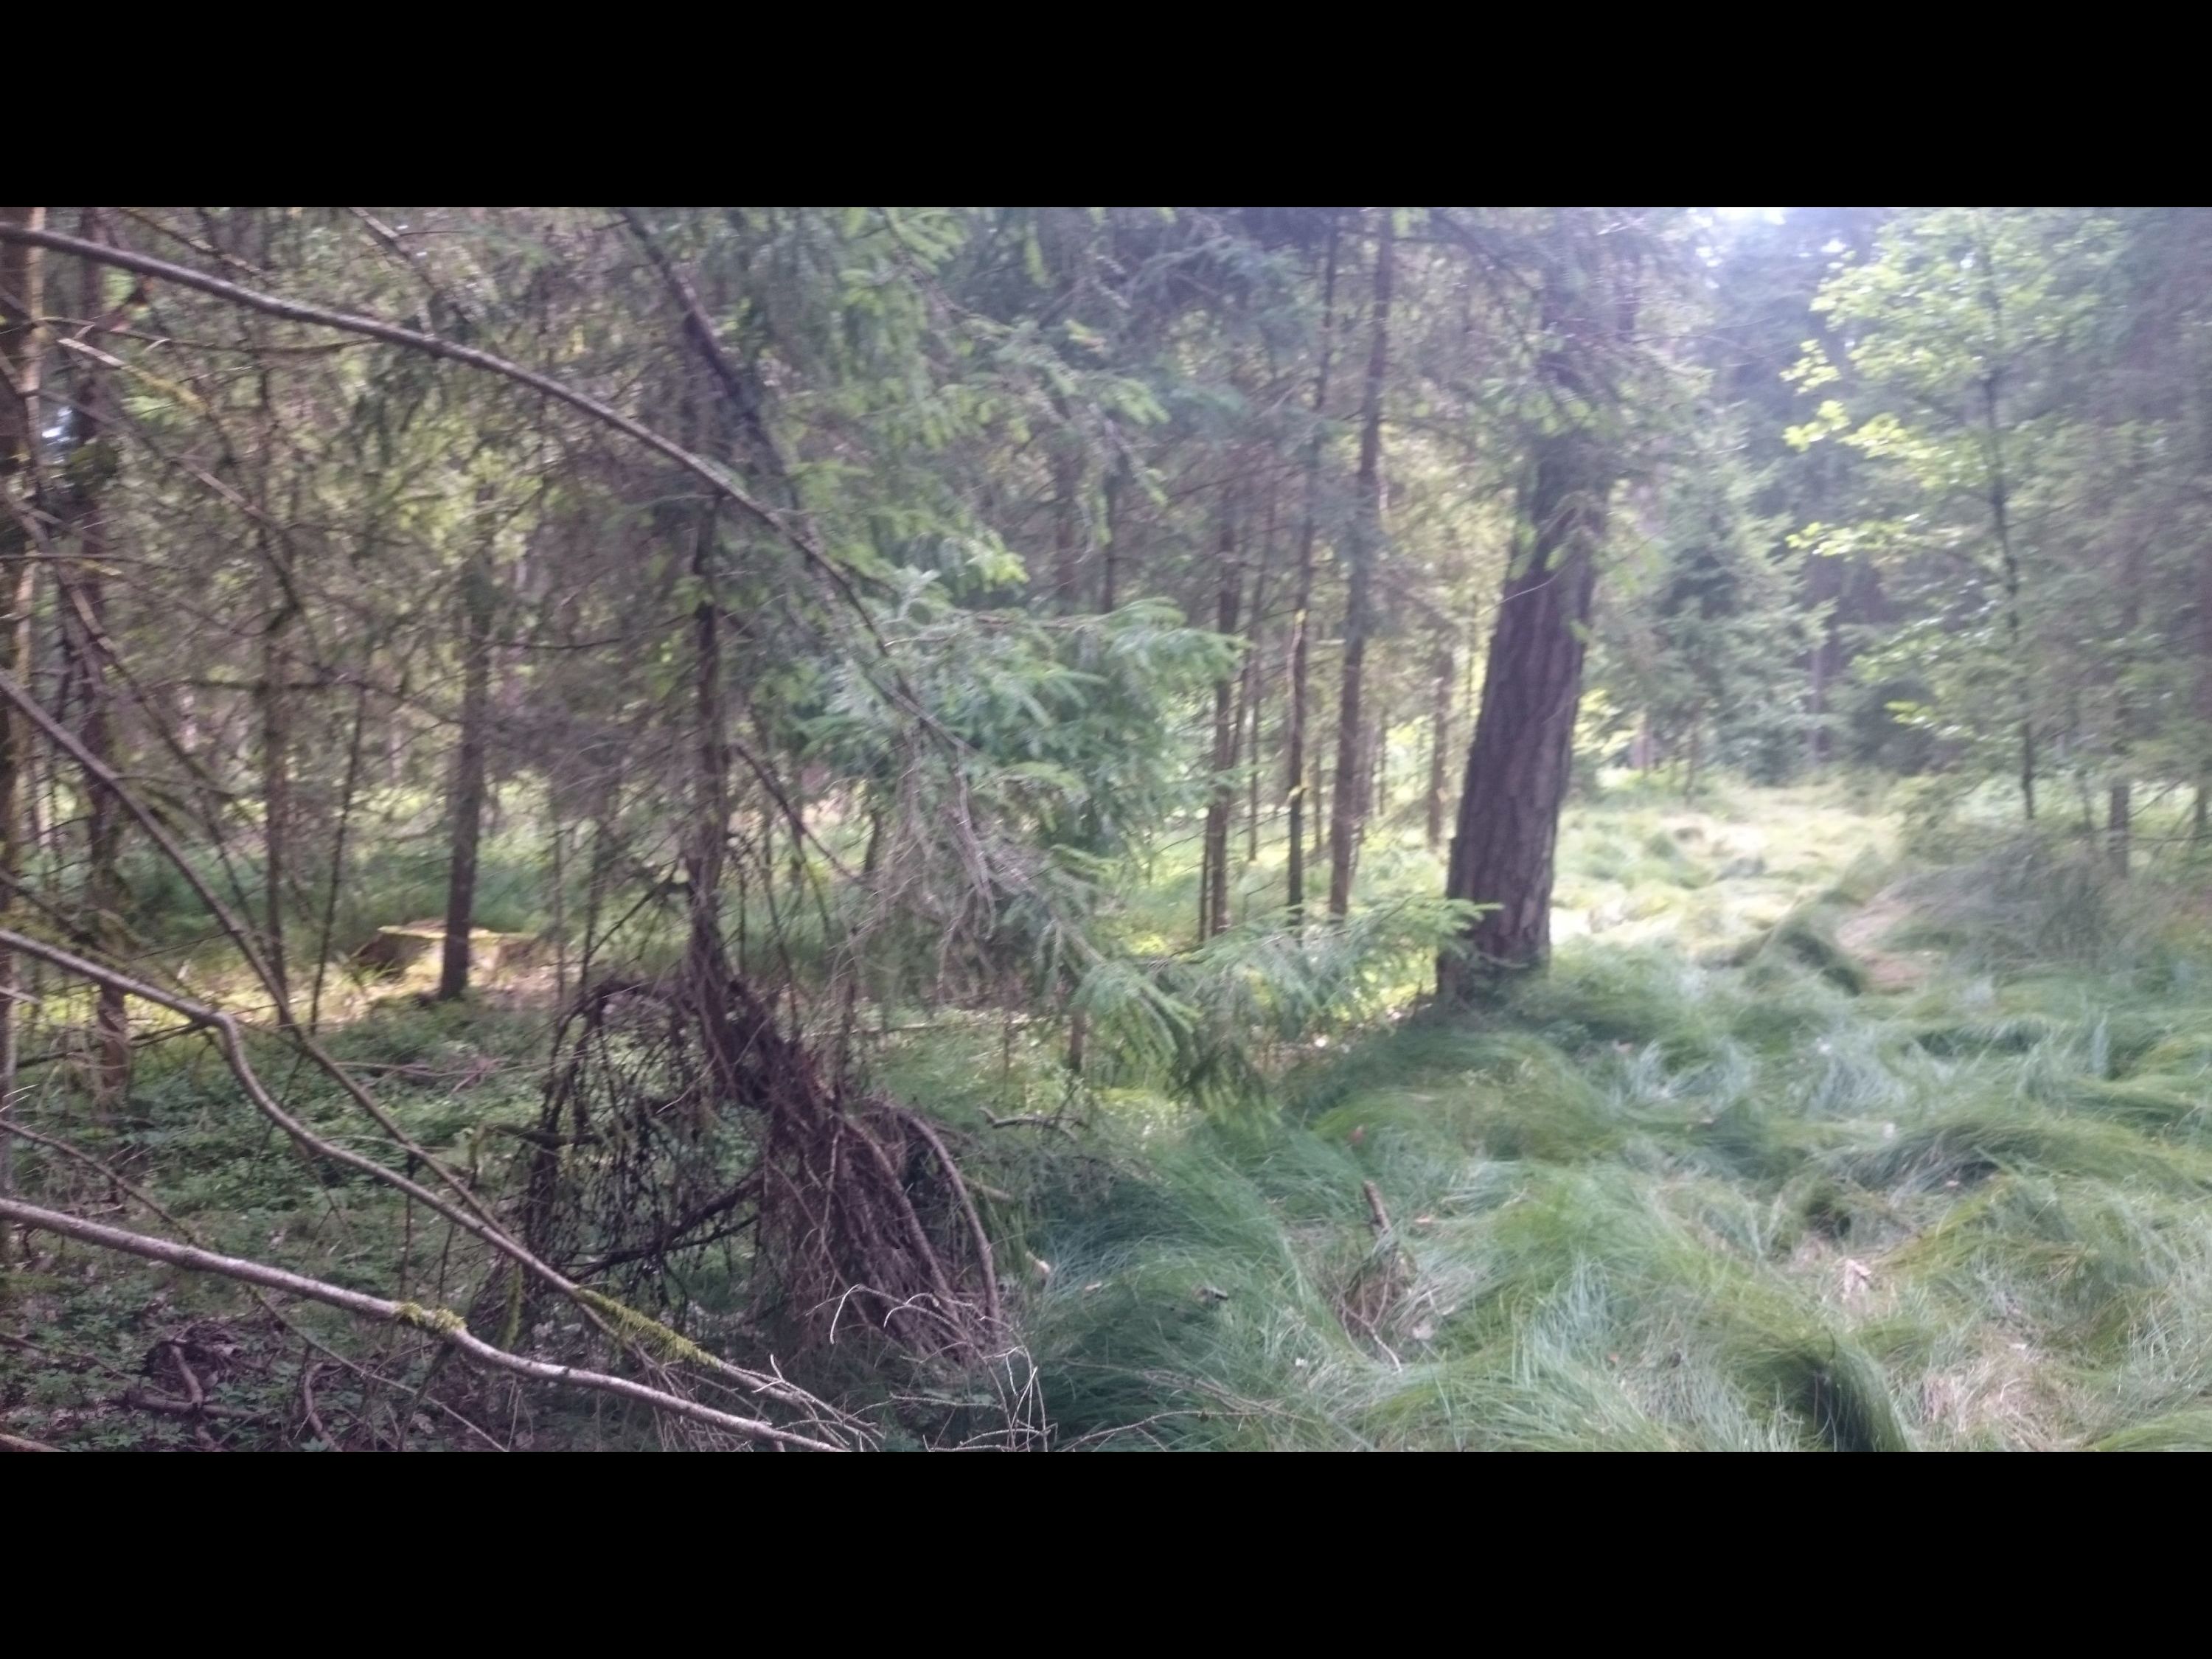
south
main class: Woodland
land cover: Spruce dominated coniferous woodland
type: hemiboreal forest and nemoral coniferous forest and mixed broadleaved-coniferous forest
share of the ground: > 75 %
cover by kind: coniferous forest trees 70 %, herbaceous plants 15 %, lichens and mosses 10 %, shrubs 5 %
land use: Forestry
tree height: > 5 m
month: July
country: AT
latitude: 47.1009
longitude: 16.0491
